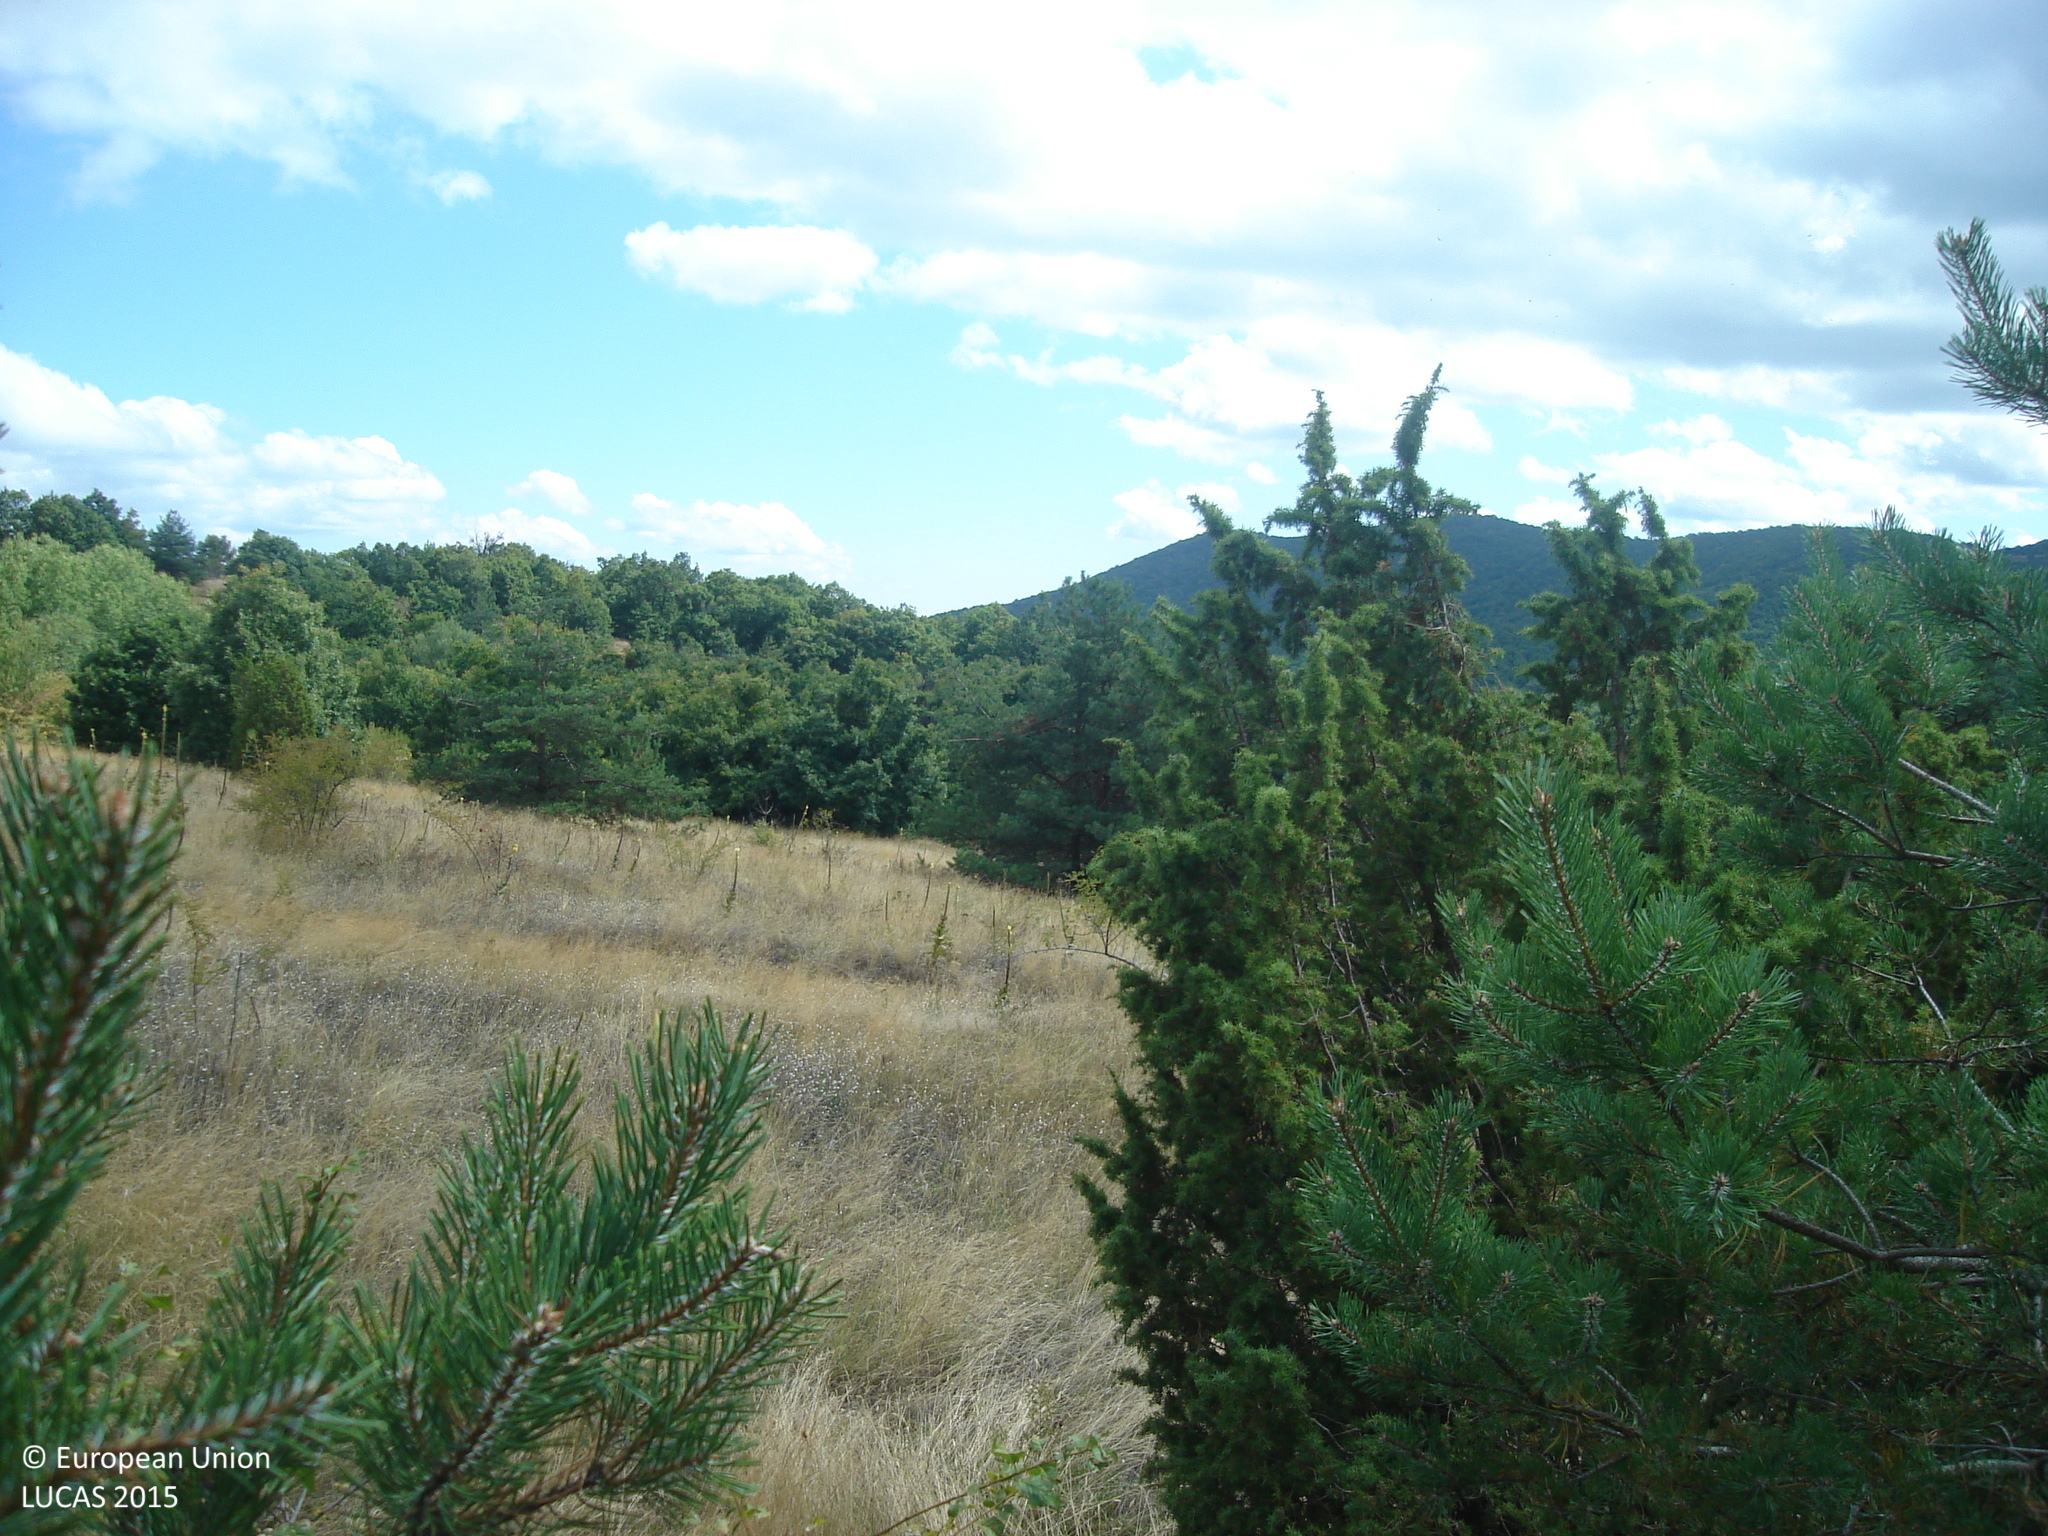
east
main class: Grassland
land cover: Grassland with sparse tree/shrub cover
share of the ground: > 75 %
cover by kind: herbaceous plants 85 %, shrubs 10 %, coniferous forest trees 5 %
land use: Semi-natural and natural areas not in use
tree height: > 5 m
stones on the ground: < 10 %
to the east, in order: Grassland with sparse tree/shrub cover; Tracks; Grassland with sparse tree/shrub cover; Tracks; Grassland with sparse tree/shrub cover; Broadleaved woodland; Rivers and streams; Broadleaved woodland; Grassland with sparse tree/shrub cover; Rivers and streams; Grassland with sparse tree/shrub cover; Broadleaved woodland
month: September
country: BG
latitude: 42.4543
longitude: 24.0633
